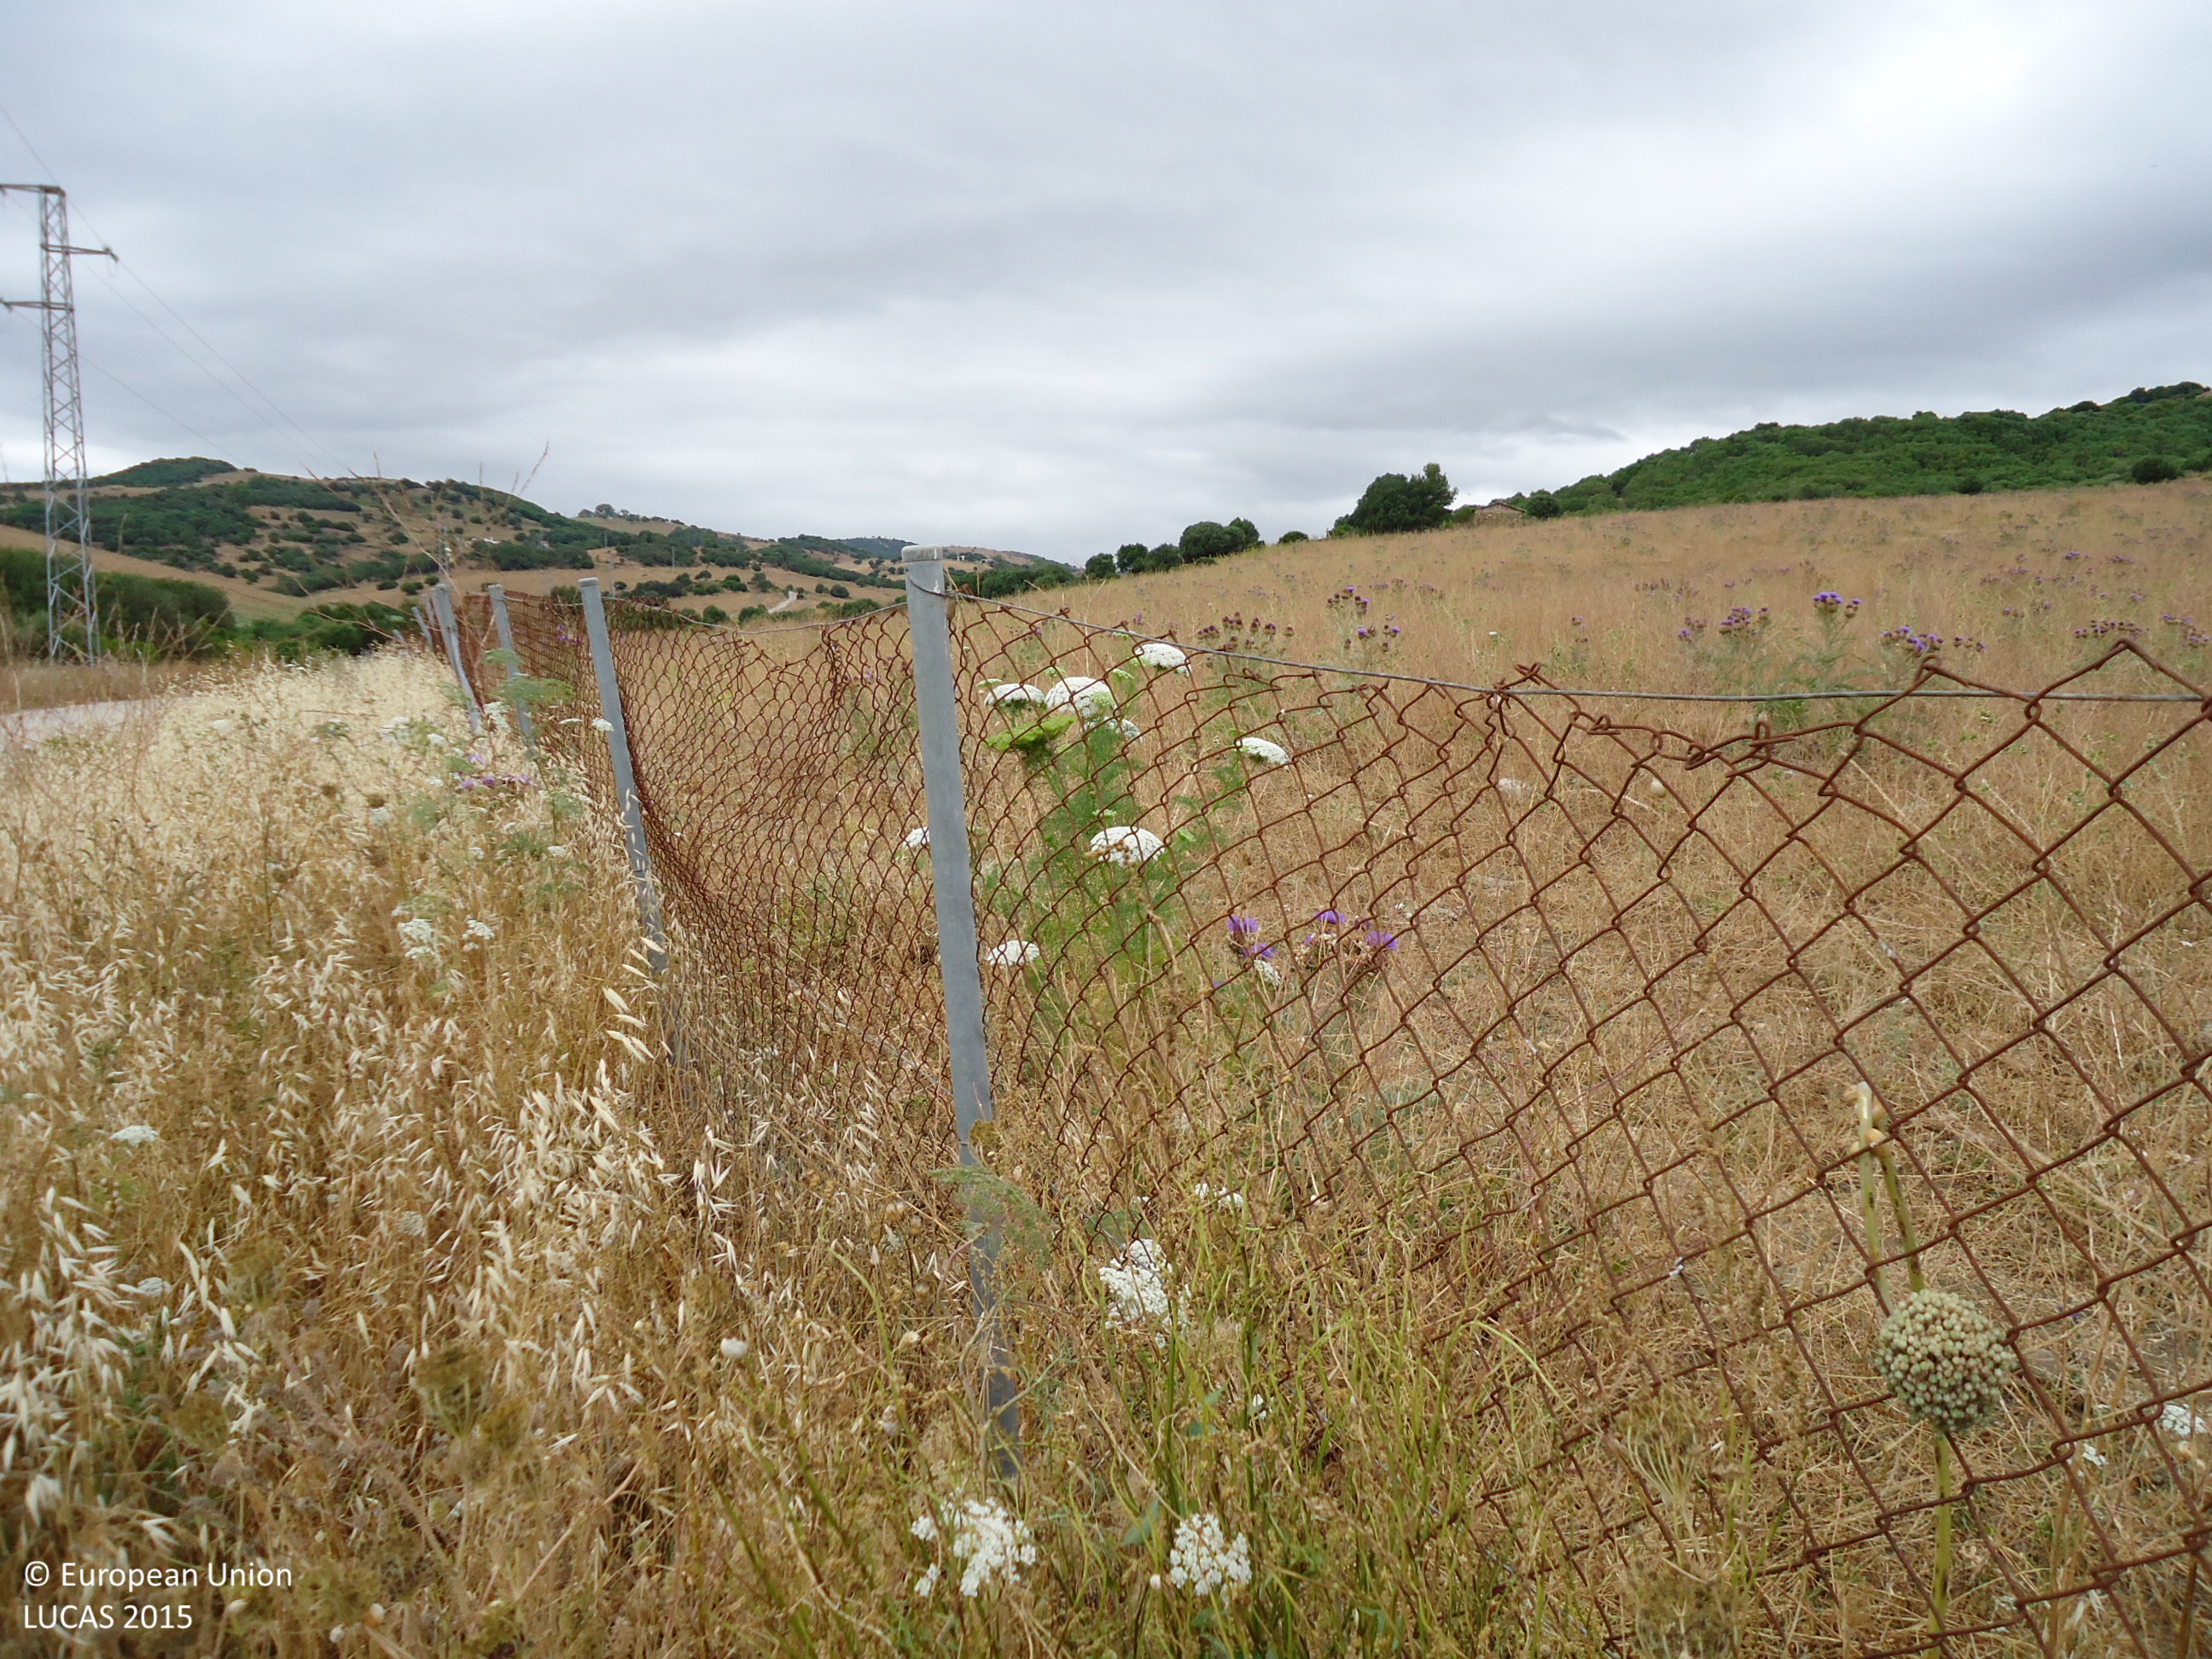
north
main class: Grassland
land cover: Spontaneously vegetated surfaces
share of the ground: > 75 %
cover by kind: herbaceous plants 100 %
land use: Agriculture (excluding fallow land and kitchen gardens)
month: June
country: ES
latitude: 36.3443
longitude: -5.3591
